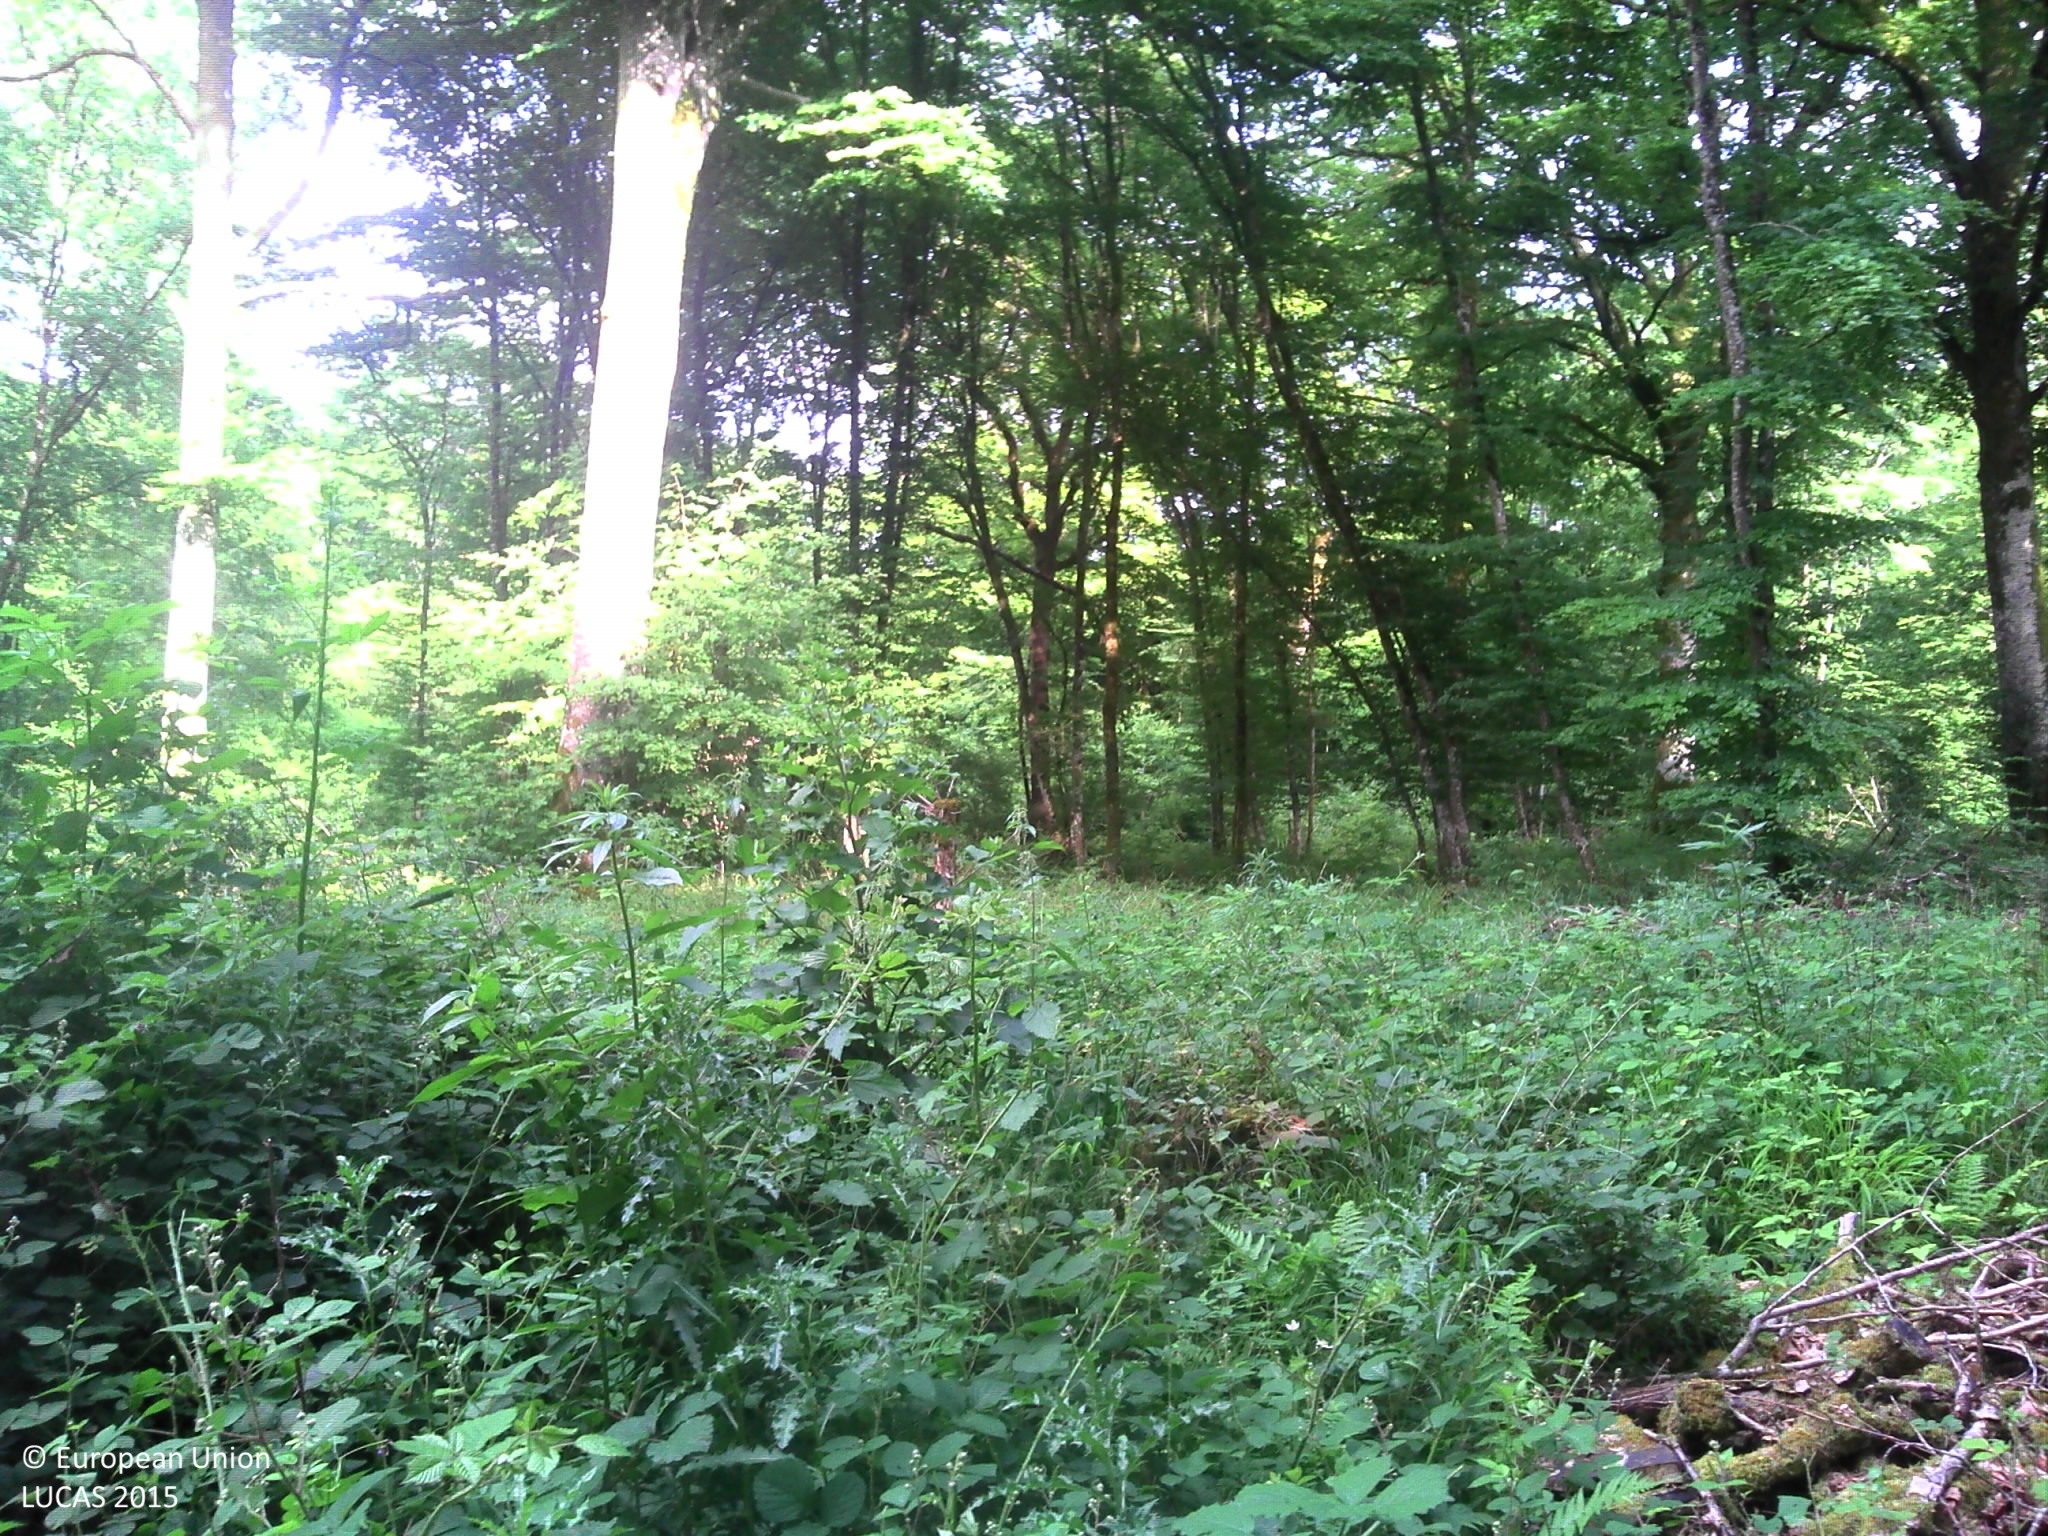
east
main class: Woodland
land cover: Broadleaved woodland
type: mesophytic deciduous forest
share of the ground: > 75 %
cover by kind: broadleaved forest trees 80 %, shrubs 10 %, herbaceous plants 10 %
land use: Forestry
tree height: > 5 m
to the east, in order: Broadleaved woodland
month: June
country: FR
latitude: 48.3405
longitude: 4.9122
